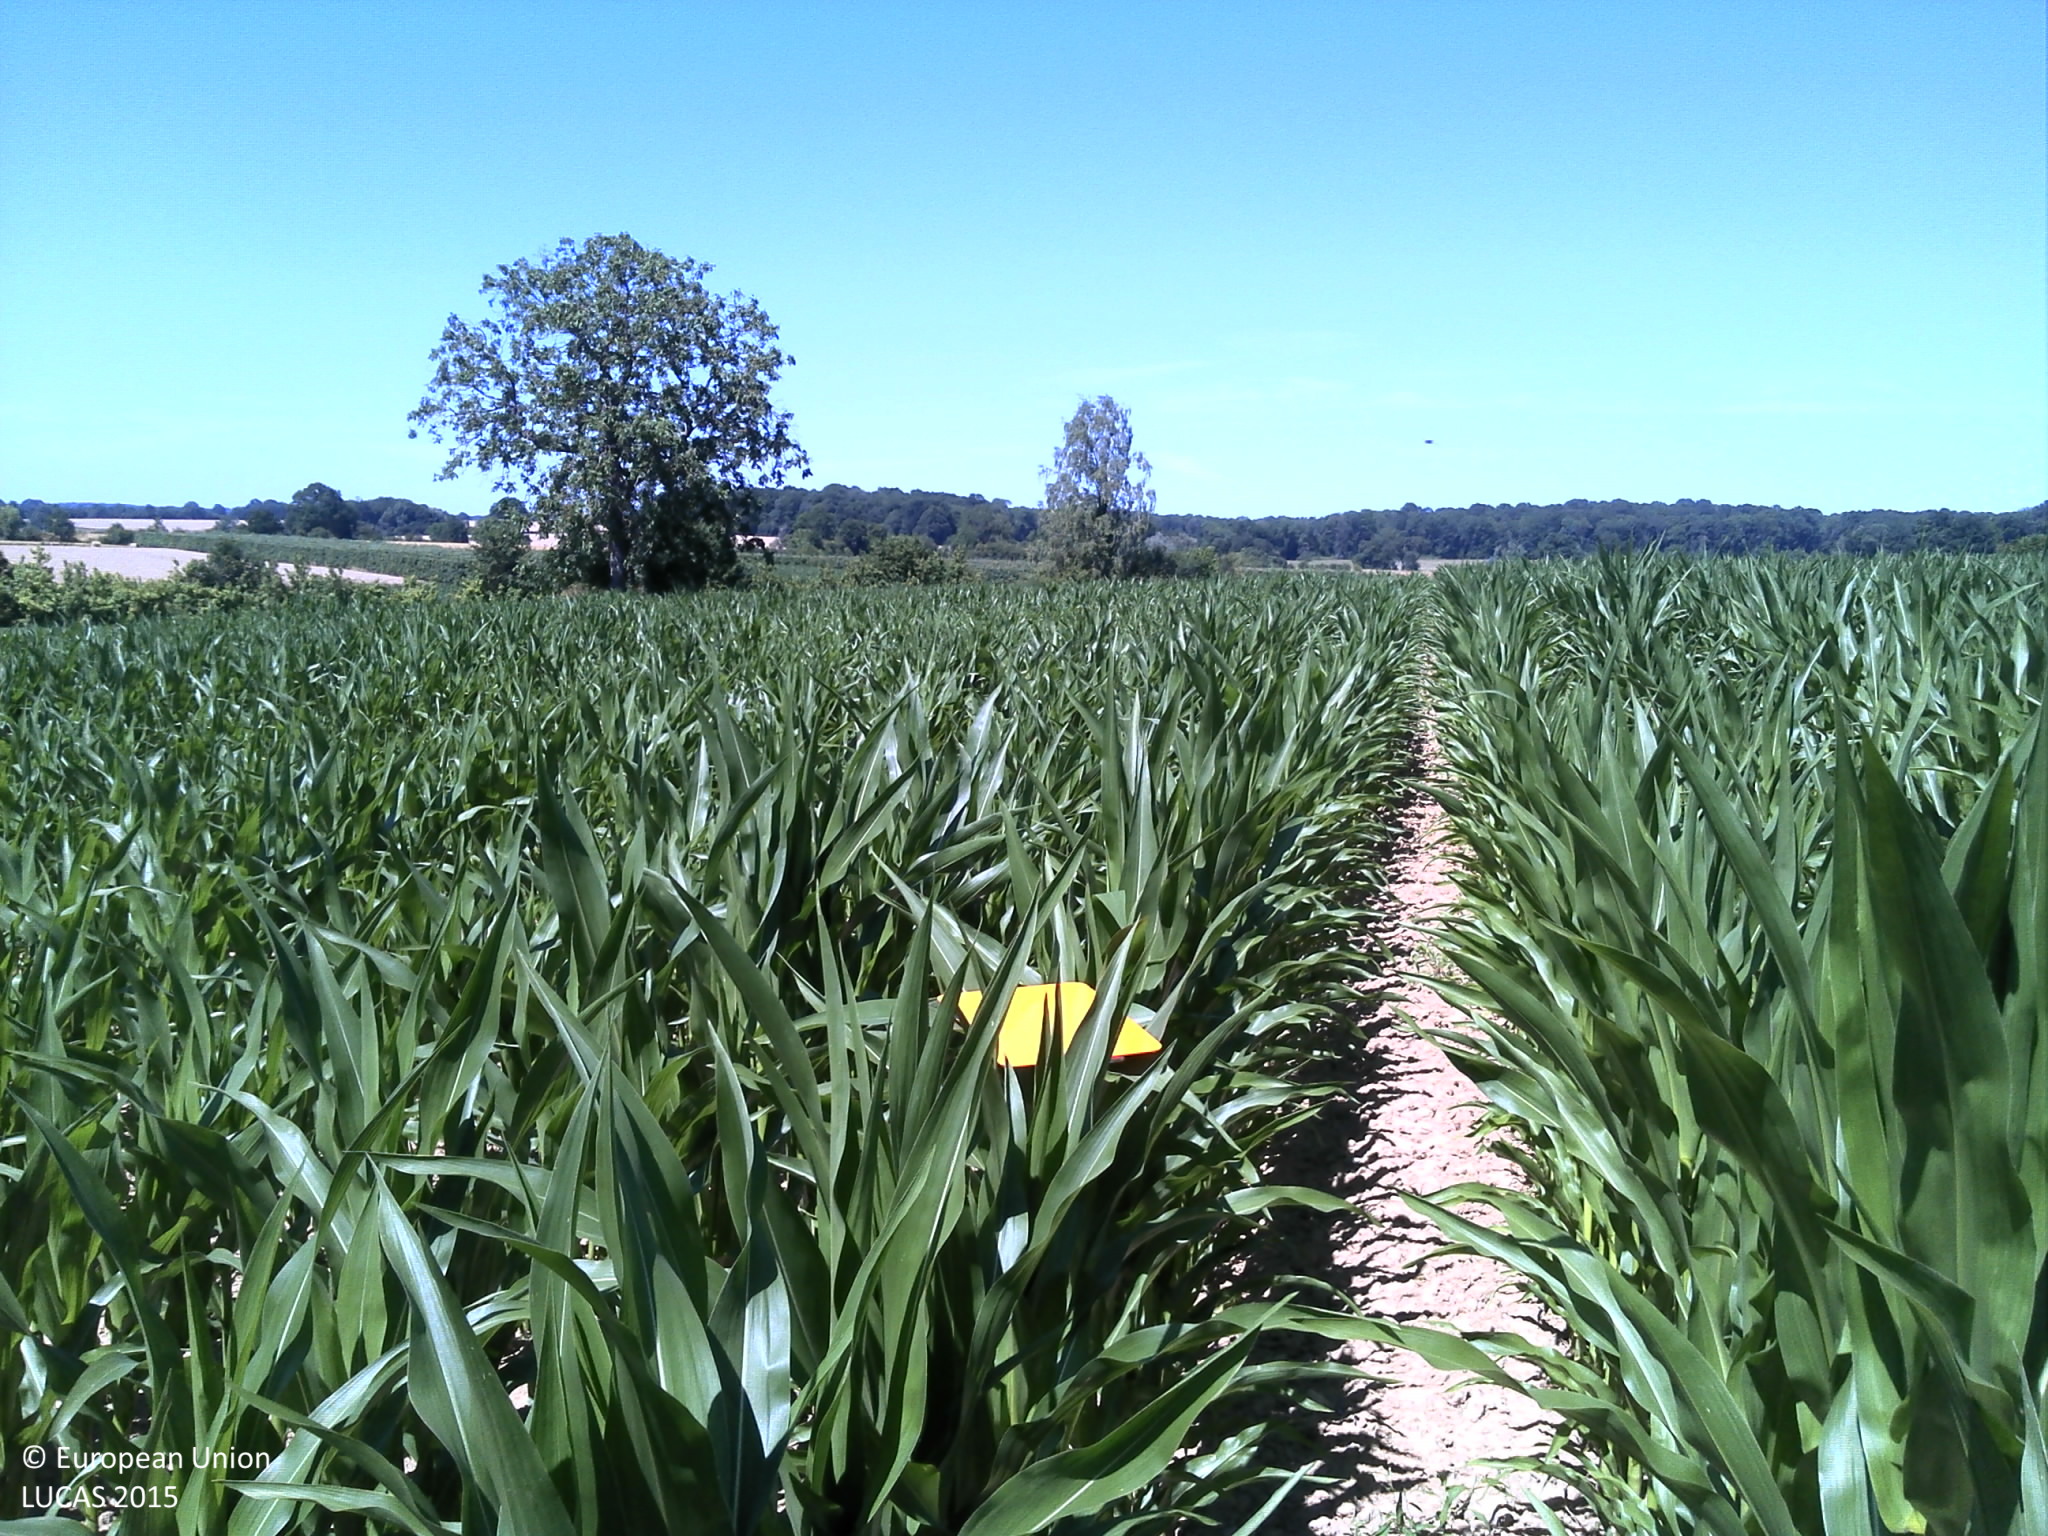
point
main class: Cropland
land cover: Maize
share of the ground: > 75 %
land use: Agriculture (excluding fallow land and kitchen gardens)
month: July
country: FR
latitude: 49.5180
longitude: 4.6510
